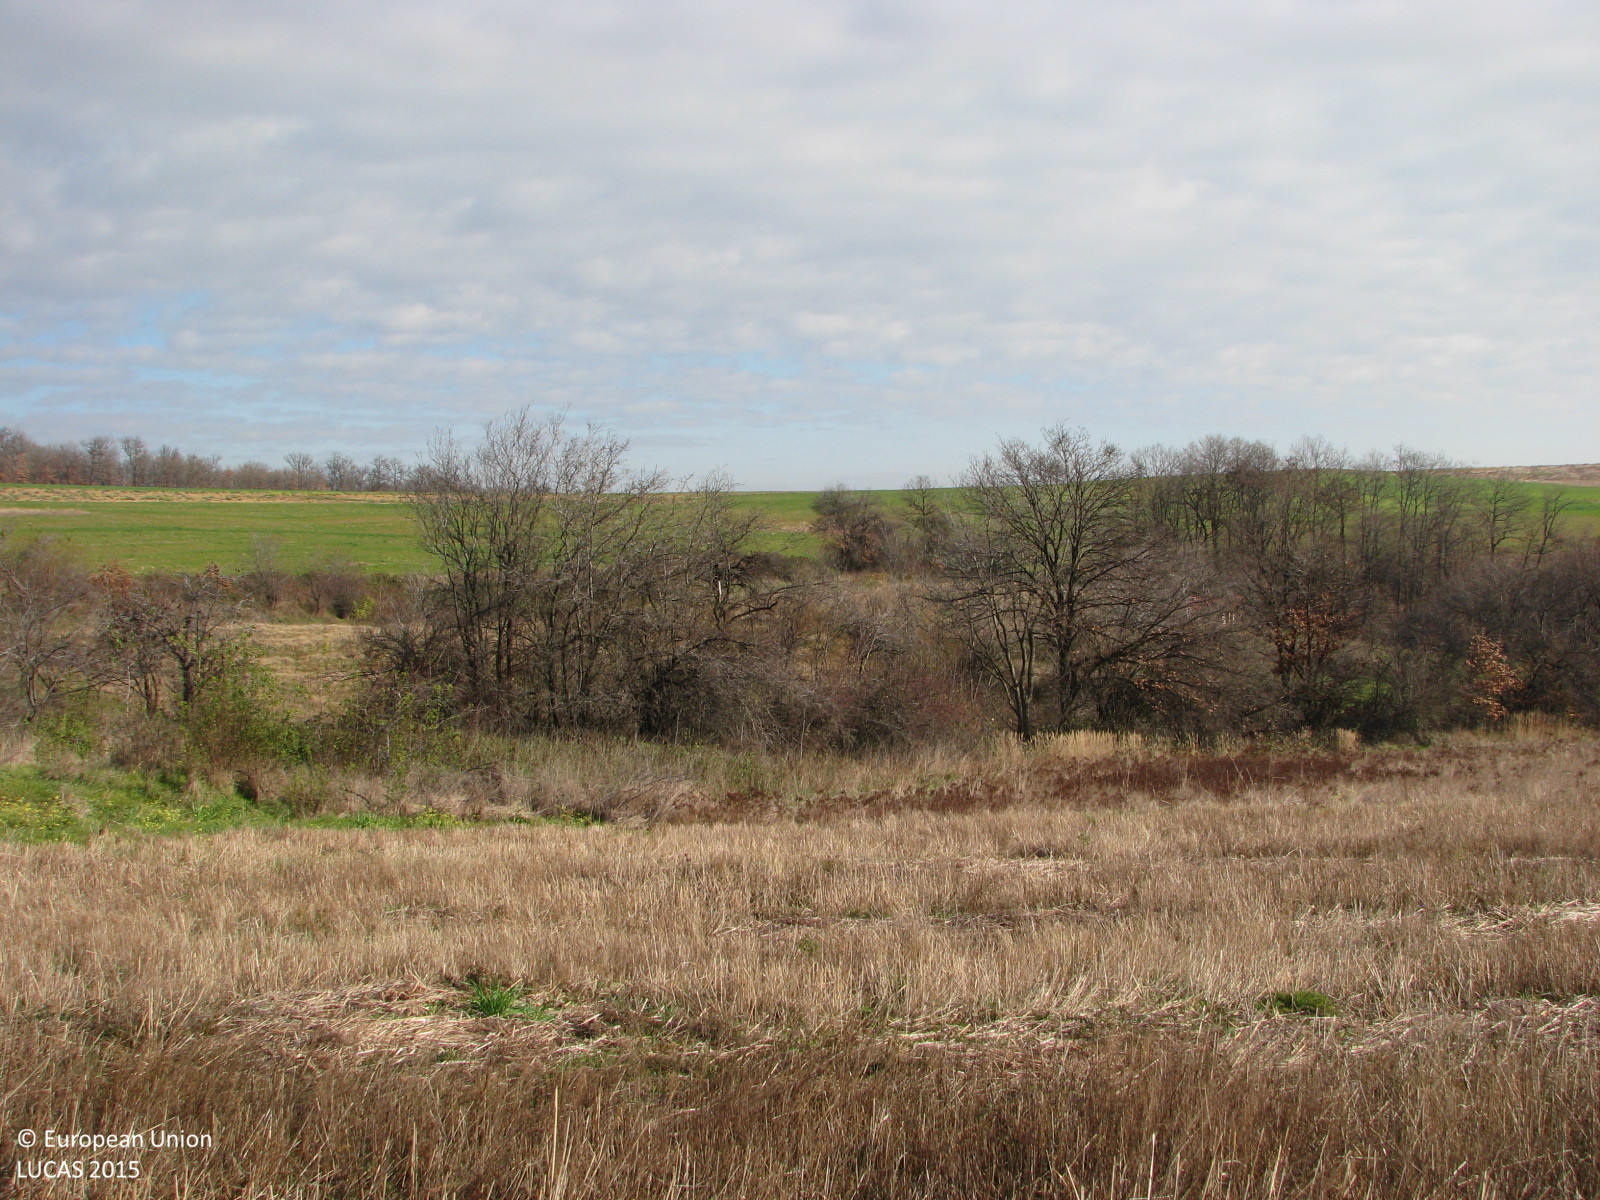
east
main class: Cropland
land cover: Rye
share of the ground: > 75 %
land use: Agriculture (excluding fallow land and kitchen gardens)
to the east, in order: Rye; Grass margins; Broadleaved woodland; Rocks and stones; Shrubland with sparse tree cover; Broadleaved woodland; Other bare soil; Grassland with sparse tree/shrub cover; Fences; Grass margins; Tracks; Shrubland with sparse tree cover; Rye
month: December
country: BG
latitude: 42.4897
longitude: 24.0717
